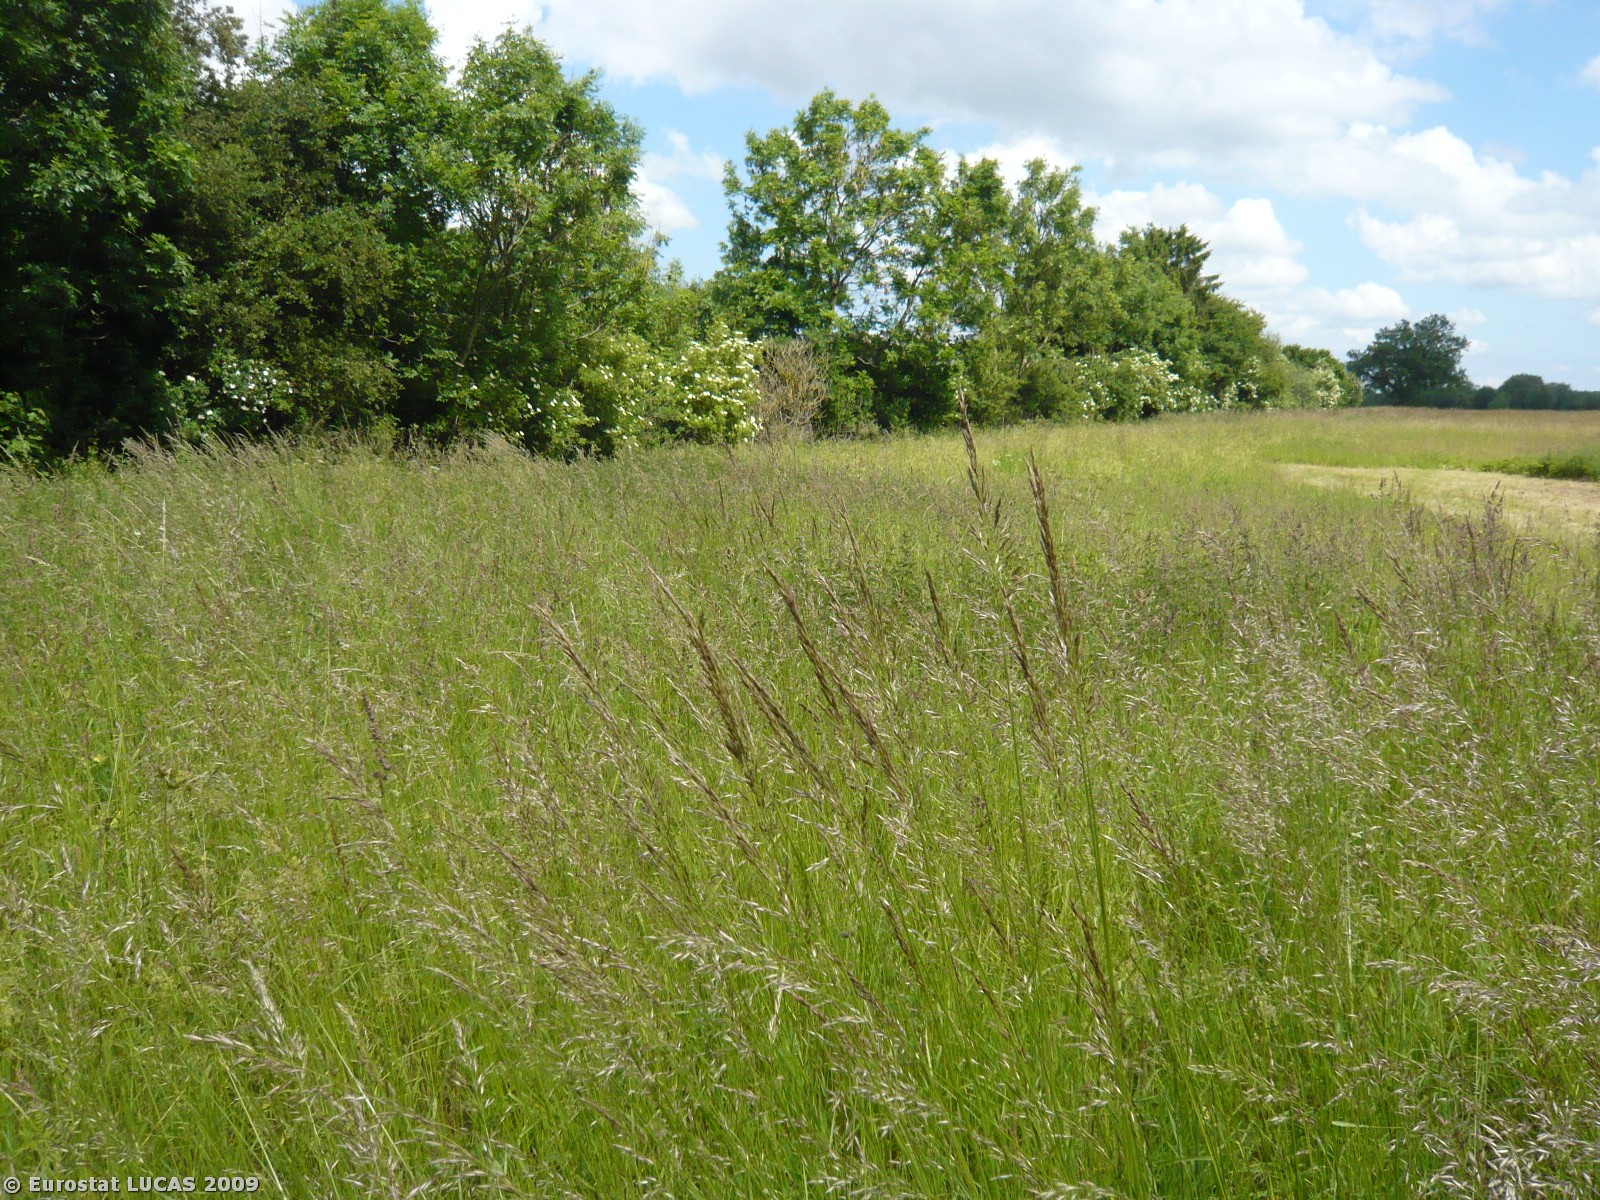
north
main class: Grassland
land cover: Grassland without tree/shrub cover
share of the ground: > 75 %
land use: Agriculture (excluding fallow land and kitchen gardens)
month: June
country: DK
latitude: 54.7563
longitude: 11.6926
